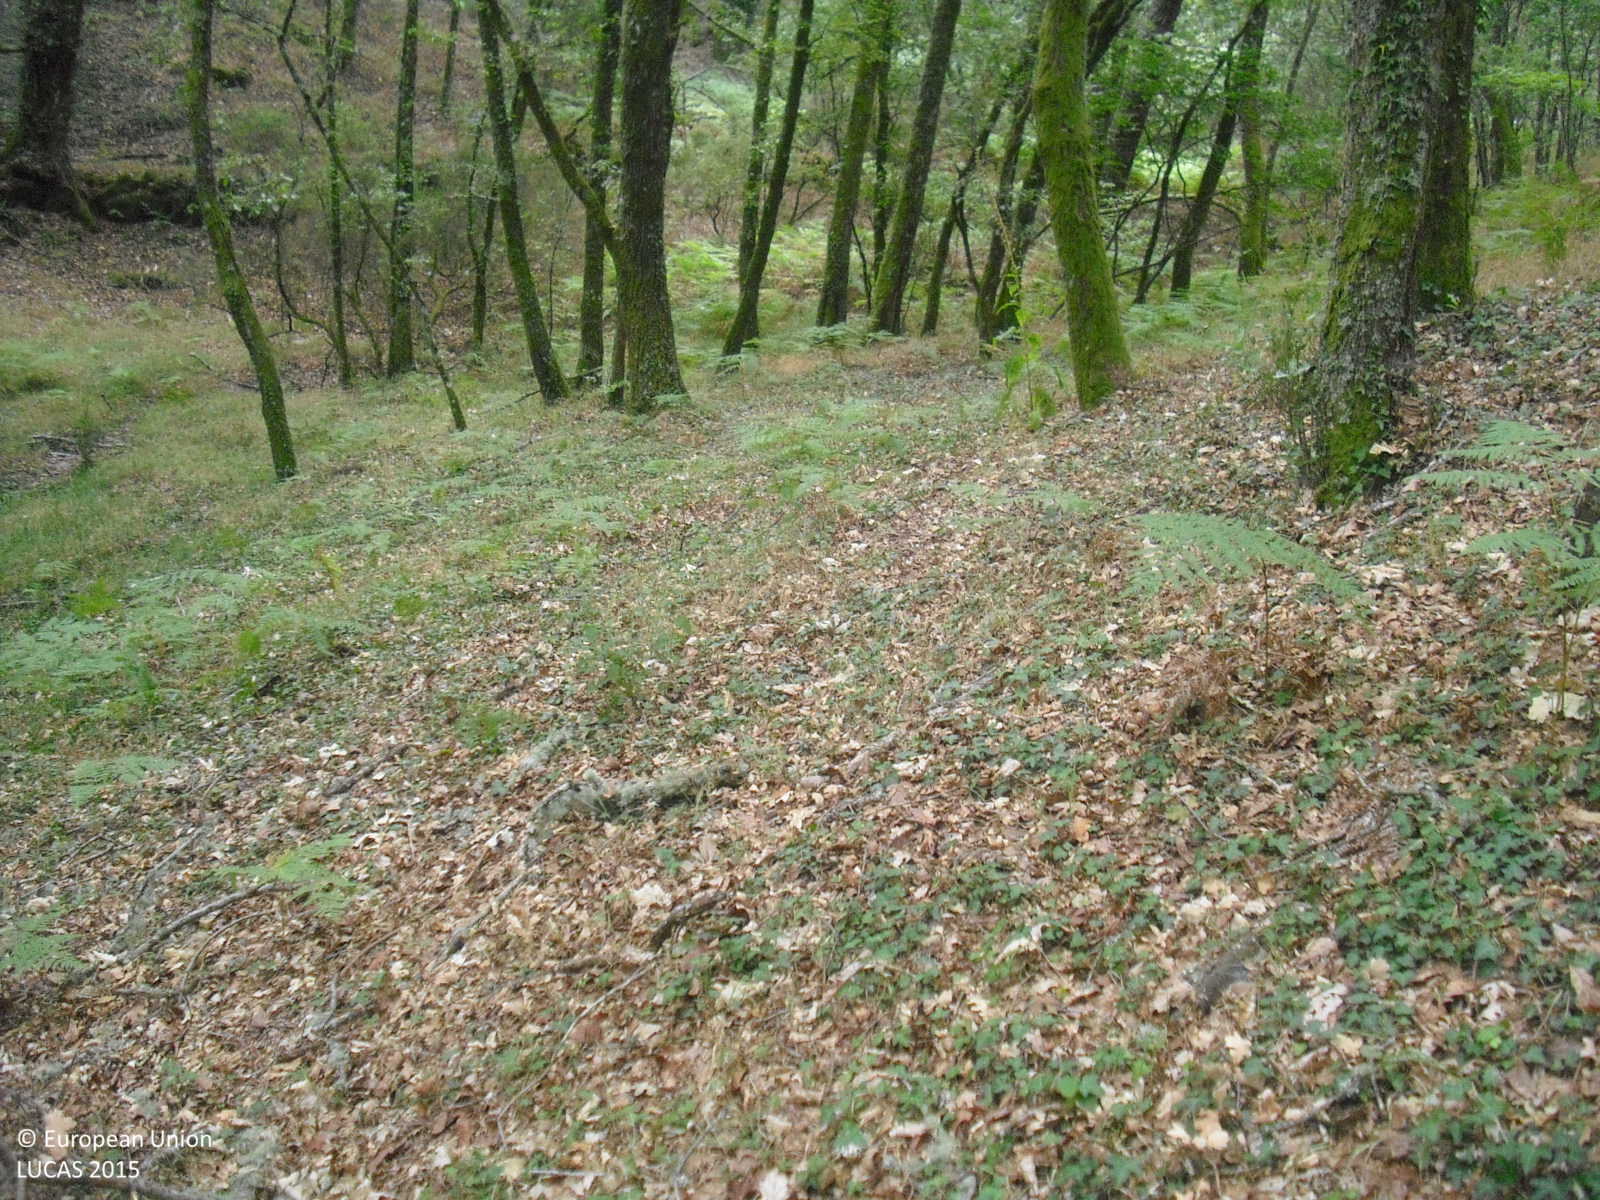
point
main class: Woodland
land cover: Broadleaved woodland
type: thermophilous deciduous forest
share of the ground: > 75 %
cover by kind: broadleaved forest trees 90 %, shrubs 10 %
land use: Forestry
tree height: > 5 m
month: July
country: ES
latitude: 42.3901
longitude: -7.6989
